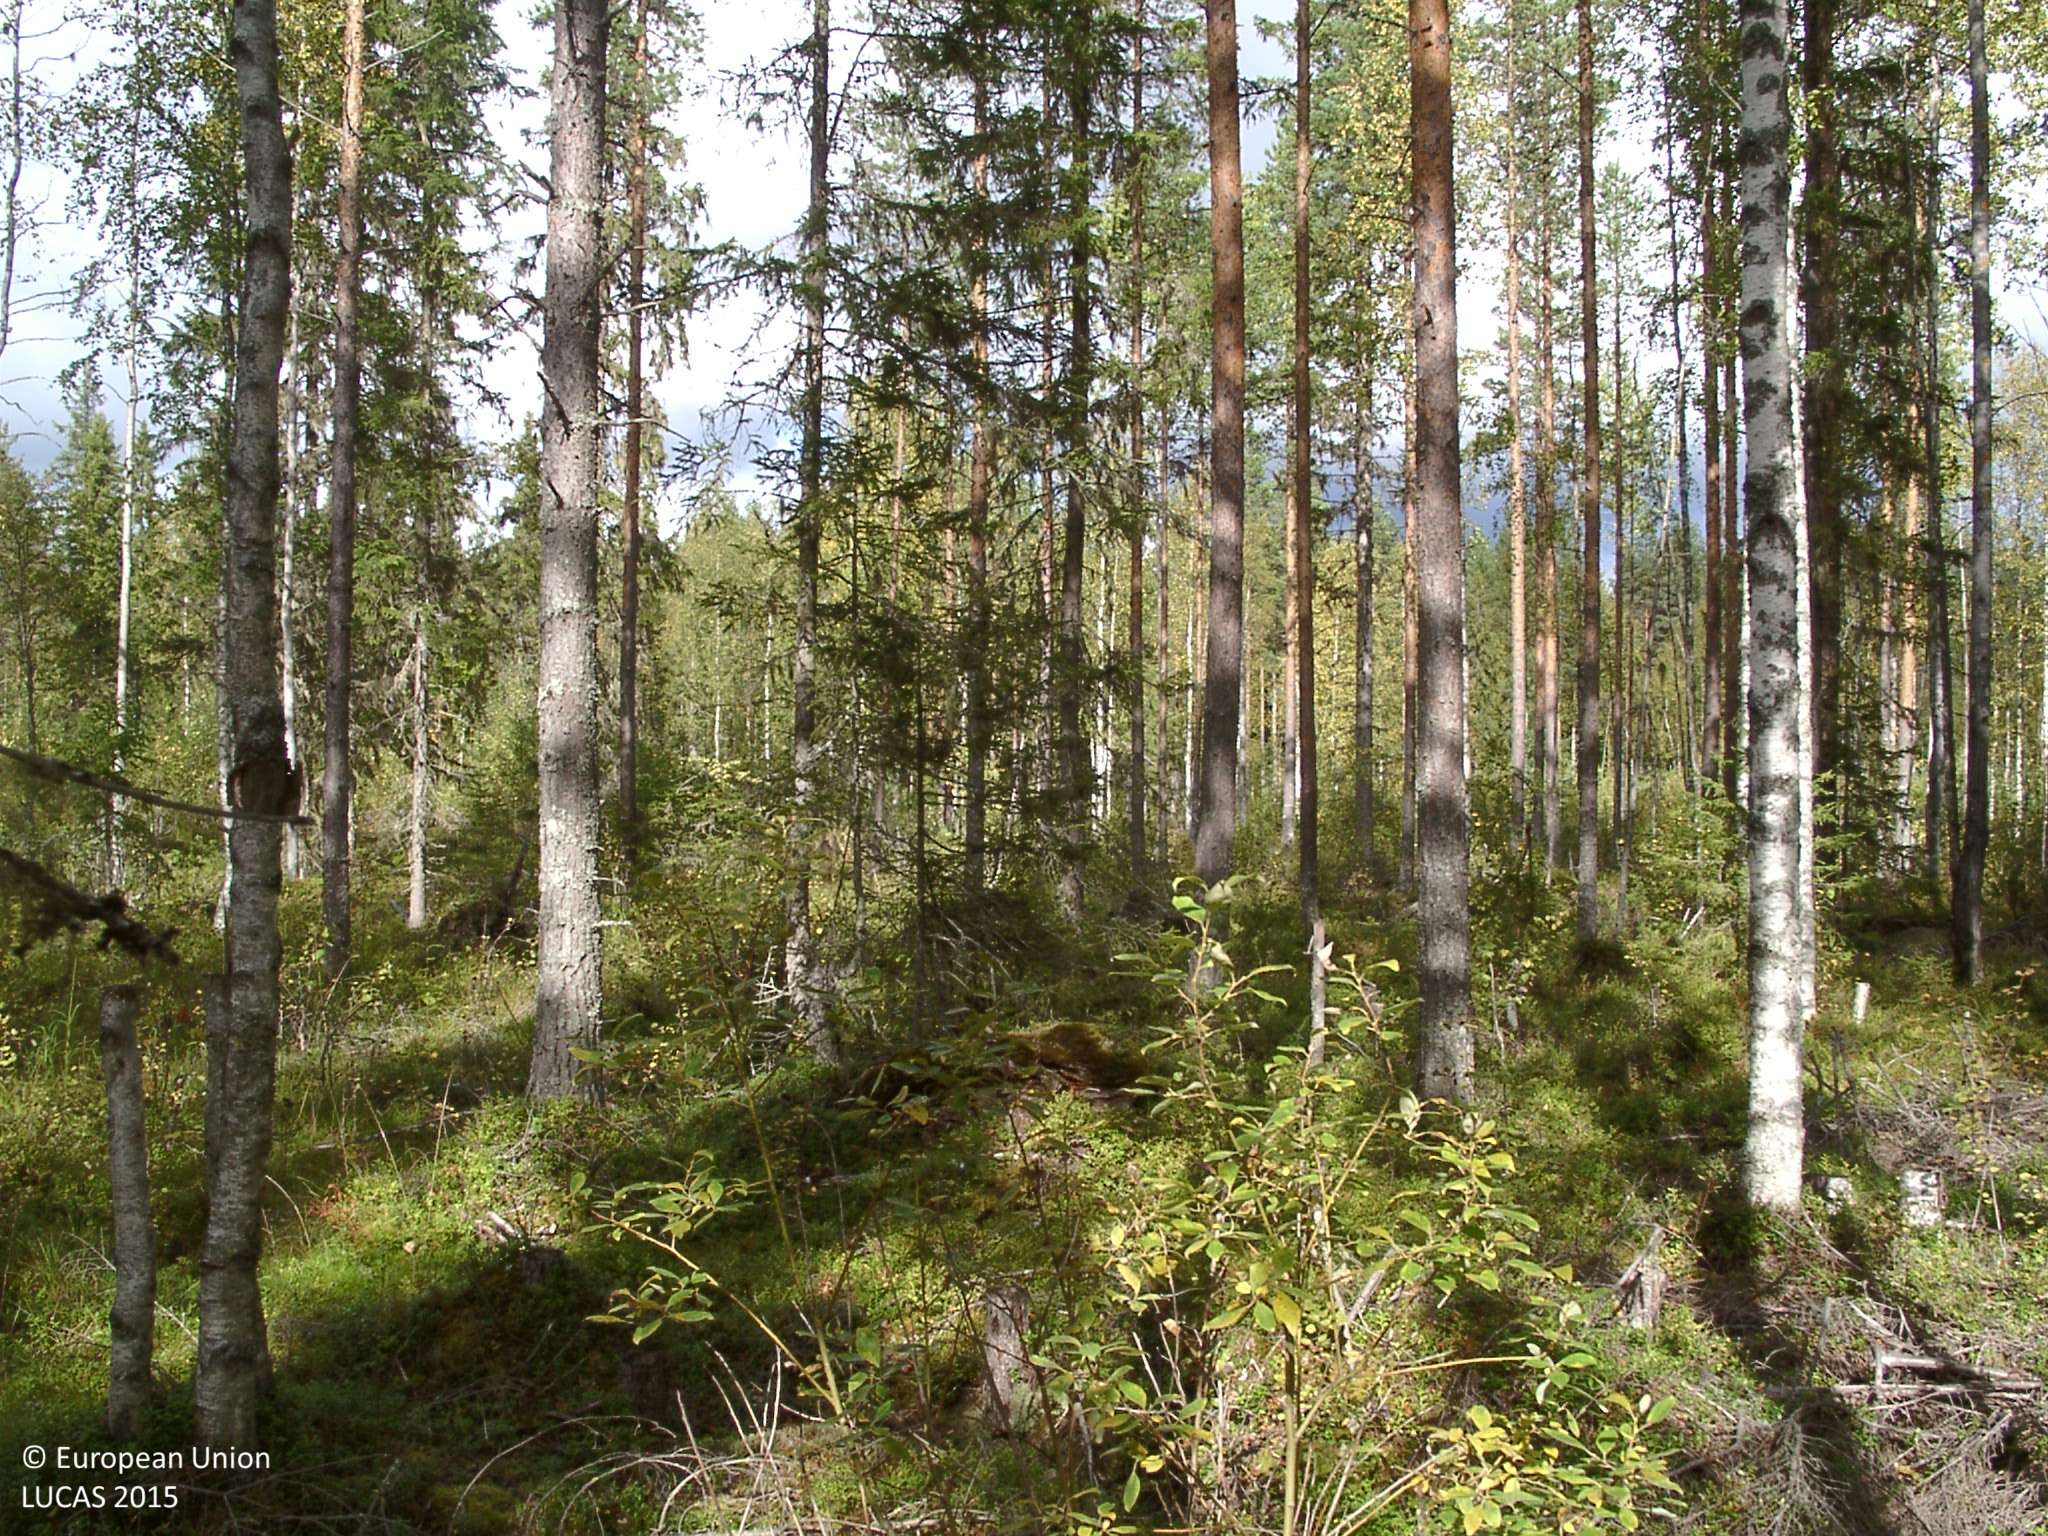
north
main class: Woodland
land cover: Other mixed woodland
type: boreal forest
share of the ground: 50 - 75 %
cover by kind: coniferous forest trees 40 %, shrubs 25 %, broadleaved forest trees 20 %, lichens and mosses 15 %
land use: Forestry
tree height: > 5 m
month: September
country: FI
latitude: 62.8741
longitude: 25.6622
